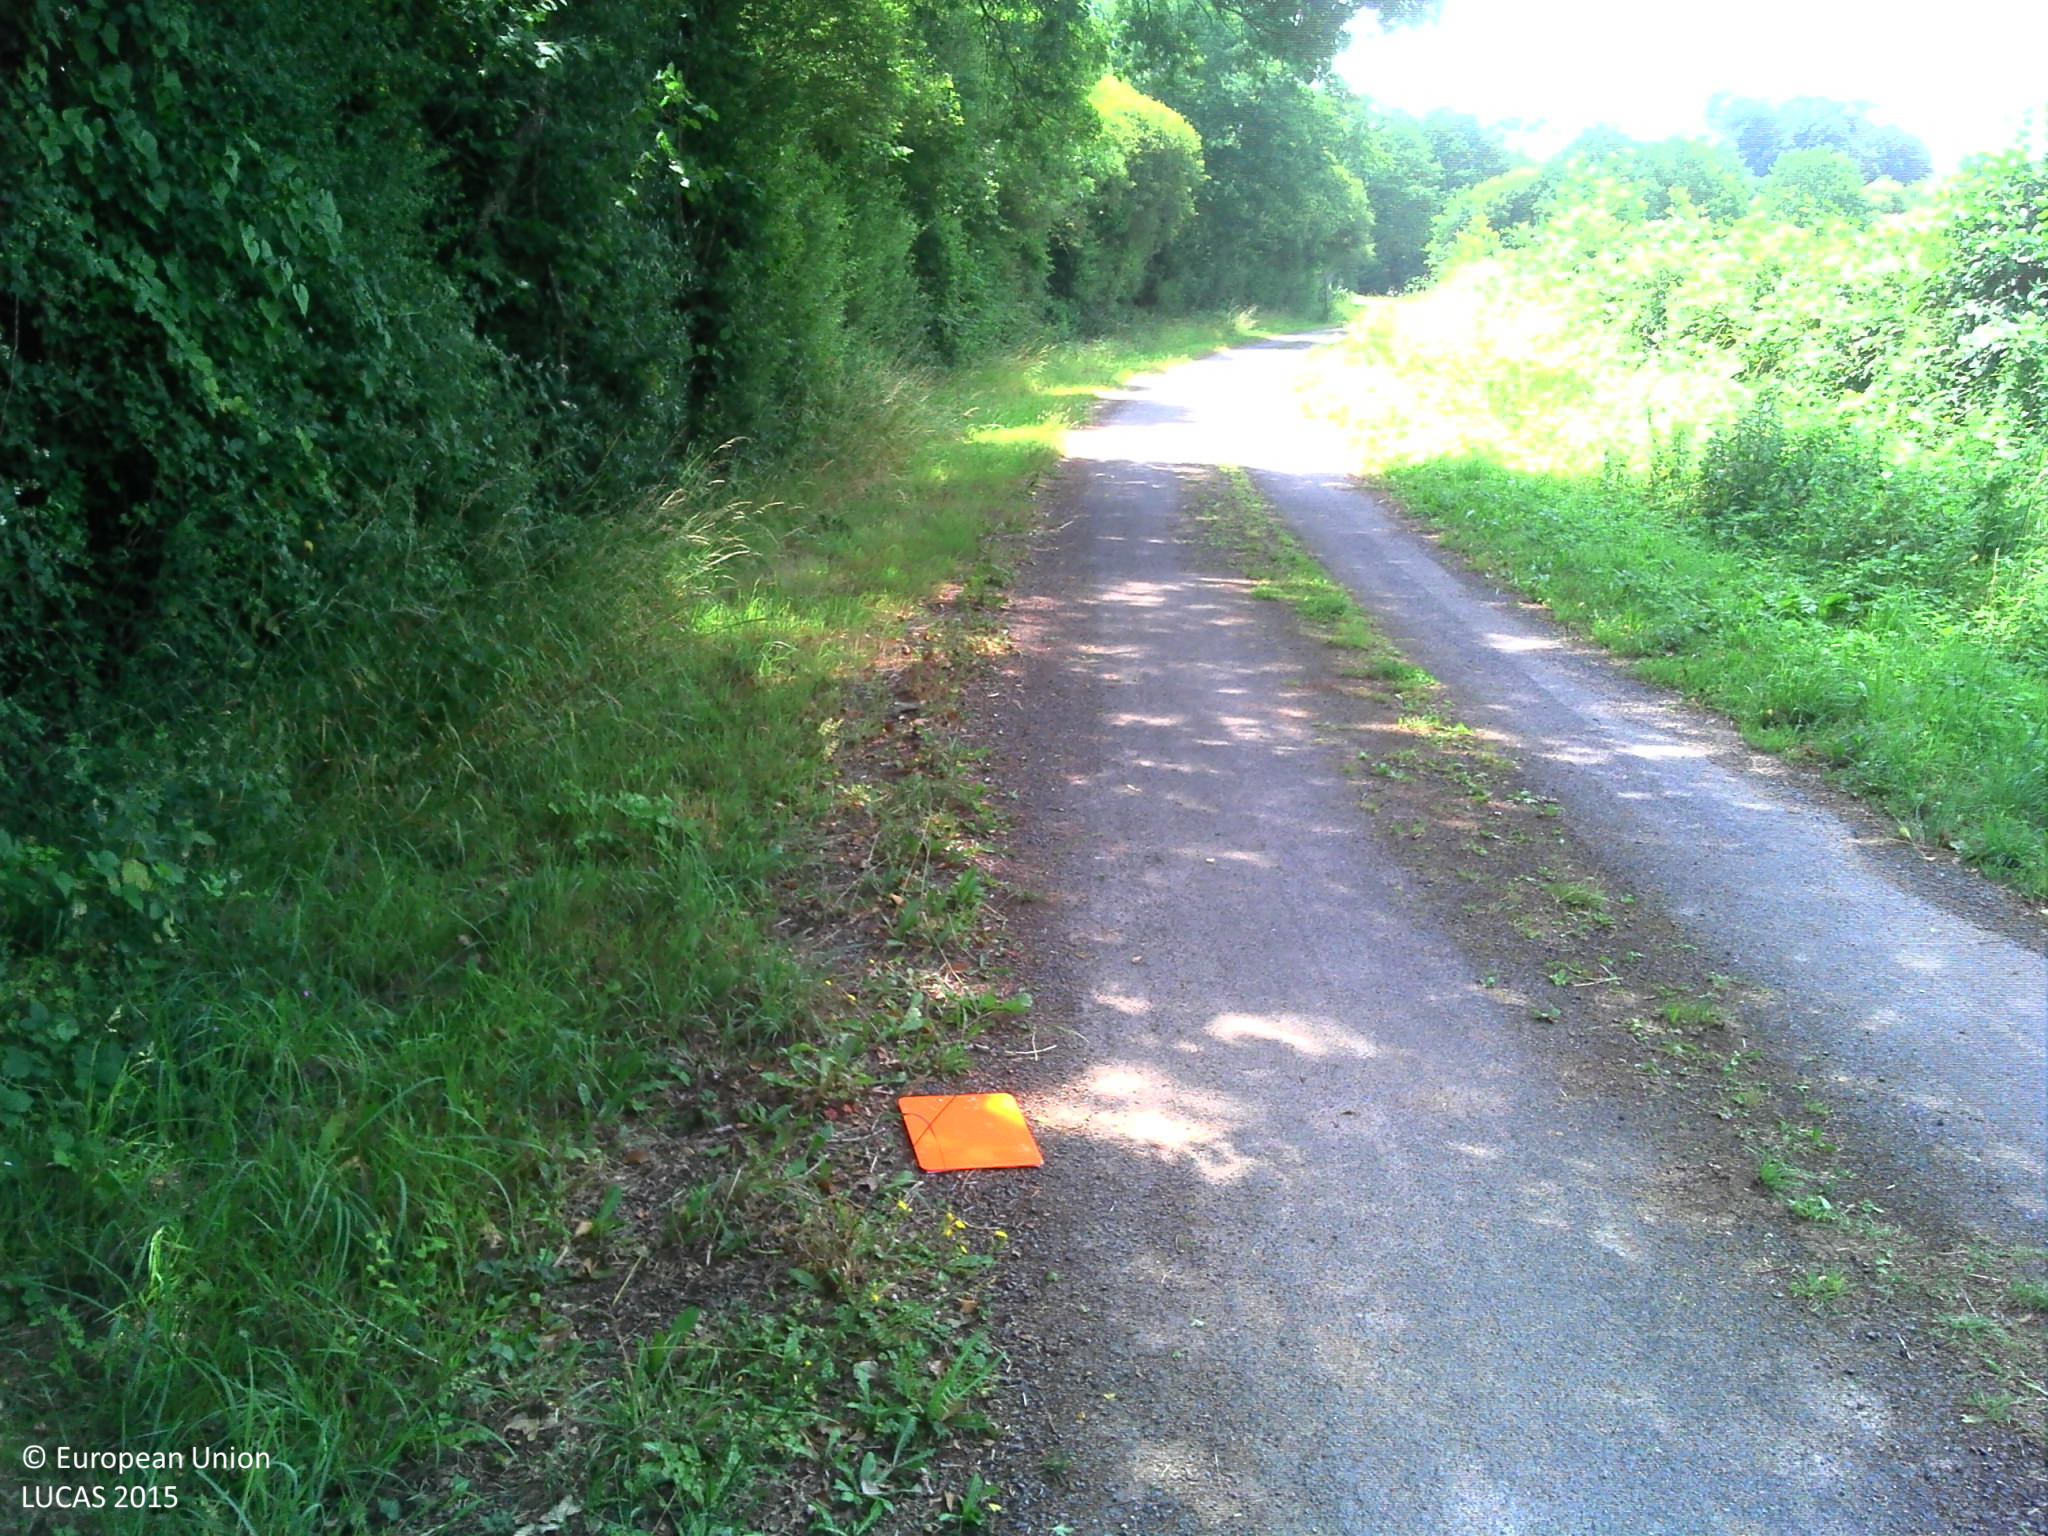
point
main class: Artificial land
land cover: Non built-up linear features
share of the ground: > 75 %
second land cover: Grassland without tree/shrub cover
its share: 10 - 25 %
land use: Road transport
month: July
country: FR
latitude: 46.9524
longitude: -0.9259
